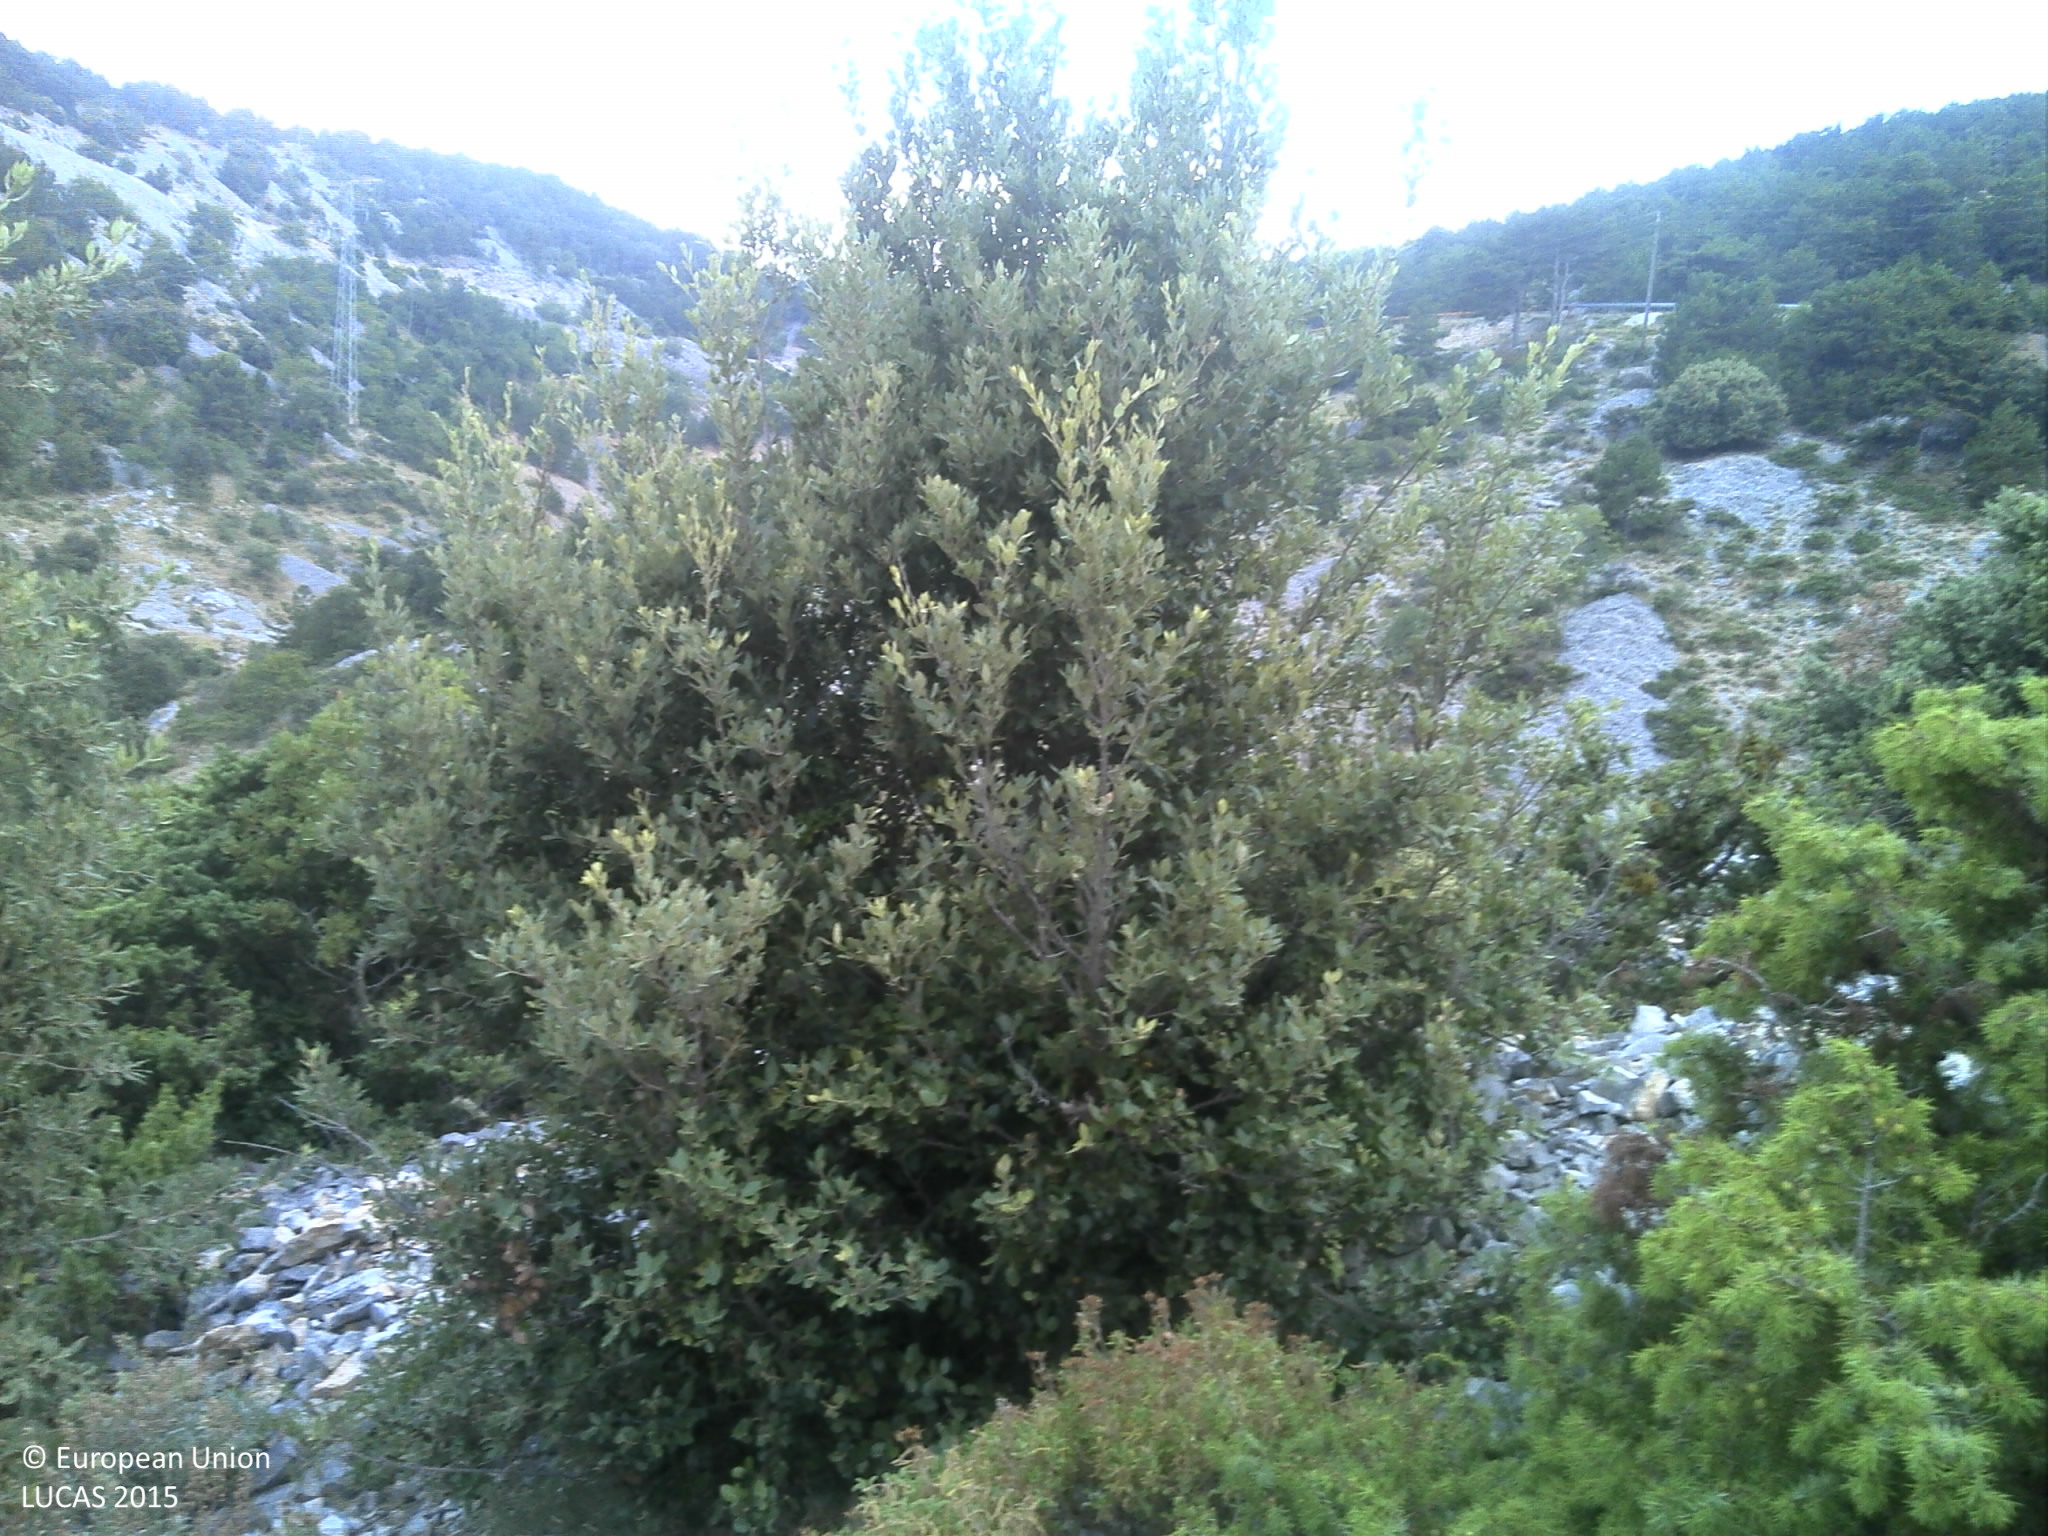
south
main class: Shrubland
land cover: Shrubland with sparse tree cover
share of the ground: > 75 %
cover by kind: shrubs 50 %, unconsolidated bare surface 25 %, consolidated bare surface 15 %, coniferous forest trees 5 %, herbaceous plants 5 %
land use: Semi-natural and natural areas not in use
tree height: < 5 m
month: July
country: HR
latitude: 43.3268
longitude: 16.5880
